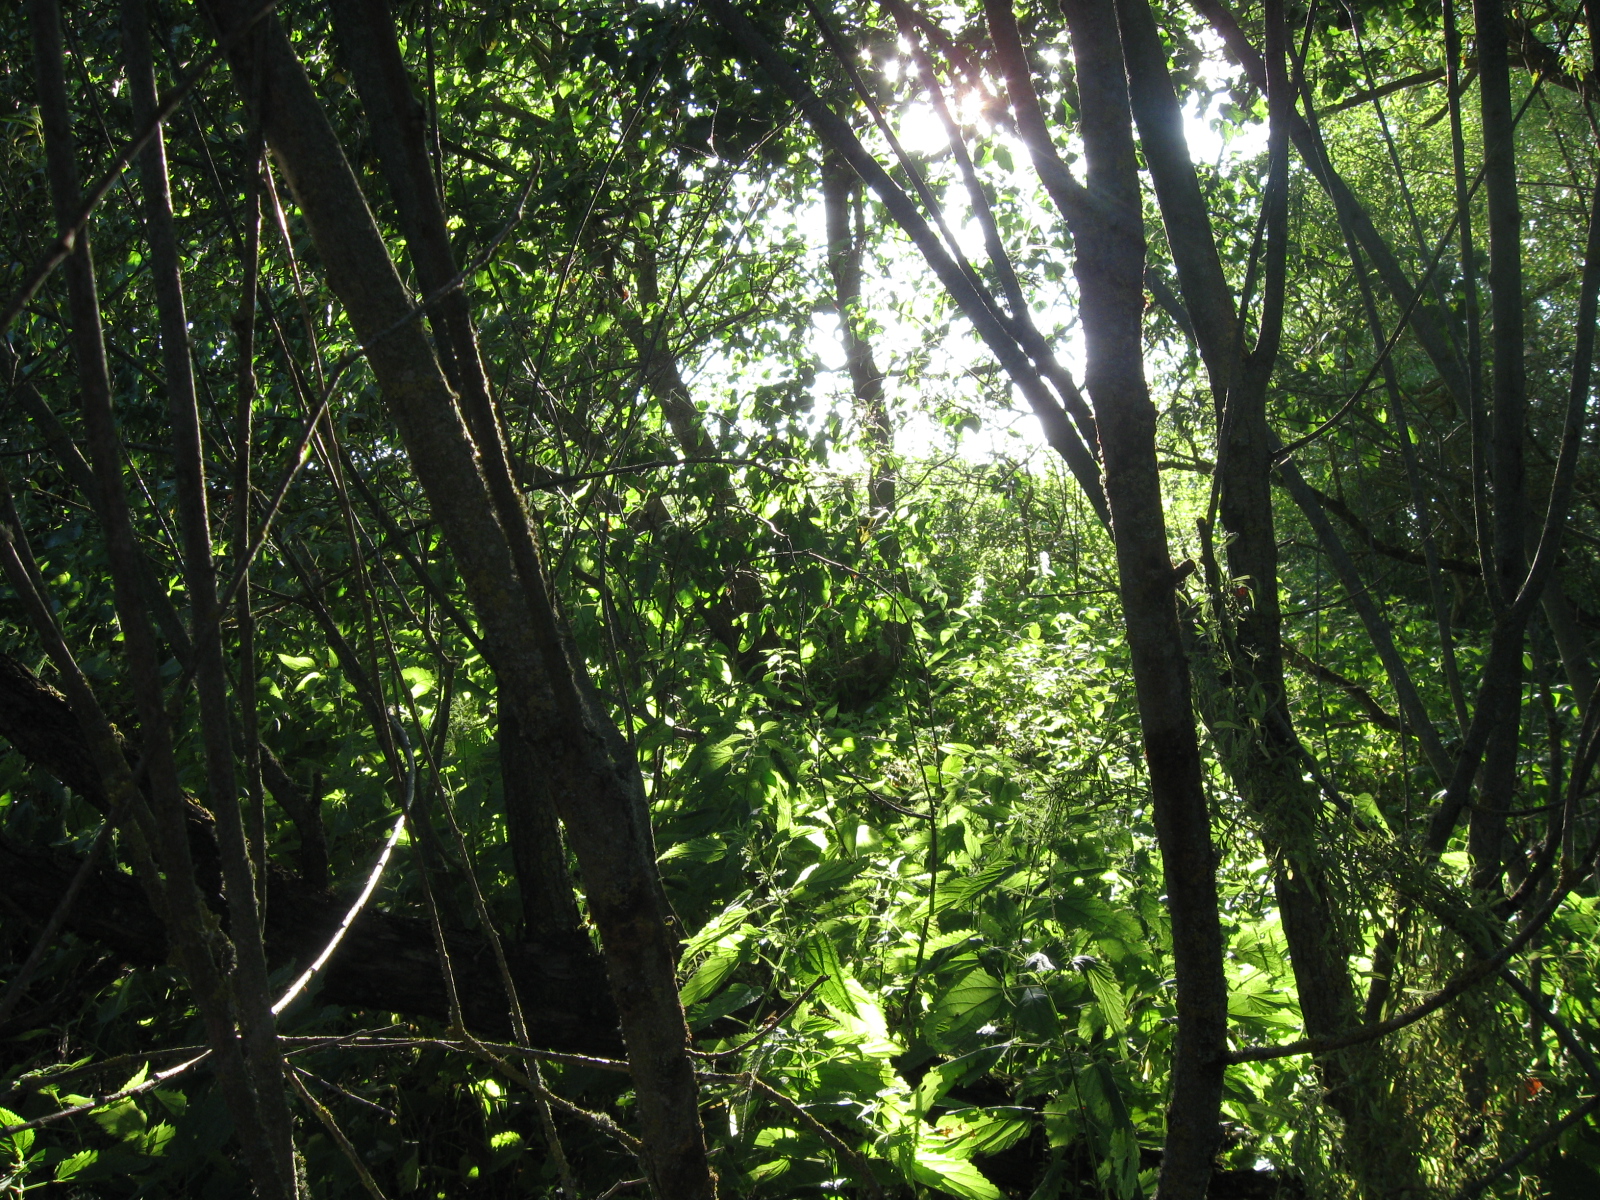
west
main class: Woodland
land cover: Broadleaved woodland
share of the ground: > 75 %
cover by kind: broadleaved forest trees 80 %, herbaceous plants 20 %
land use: Semi-natural and natural areas not in use
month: July
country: LT
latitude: 54.3338
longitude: 23.5397
